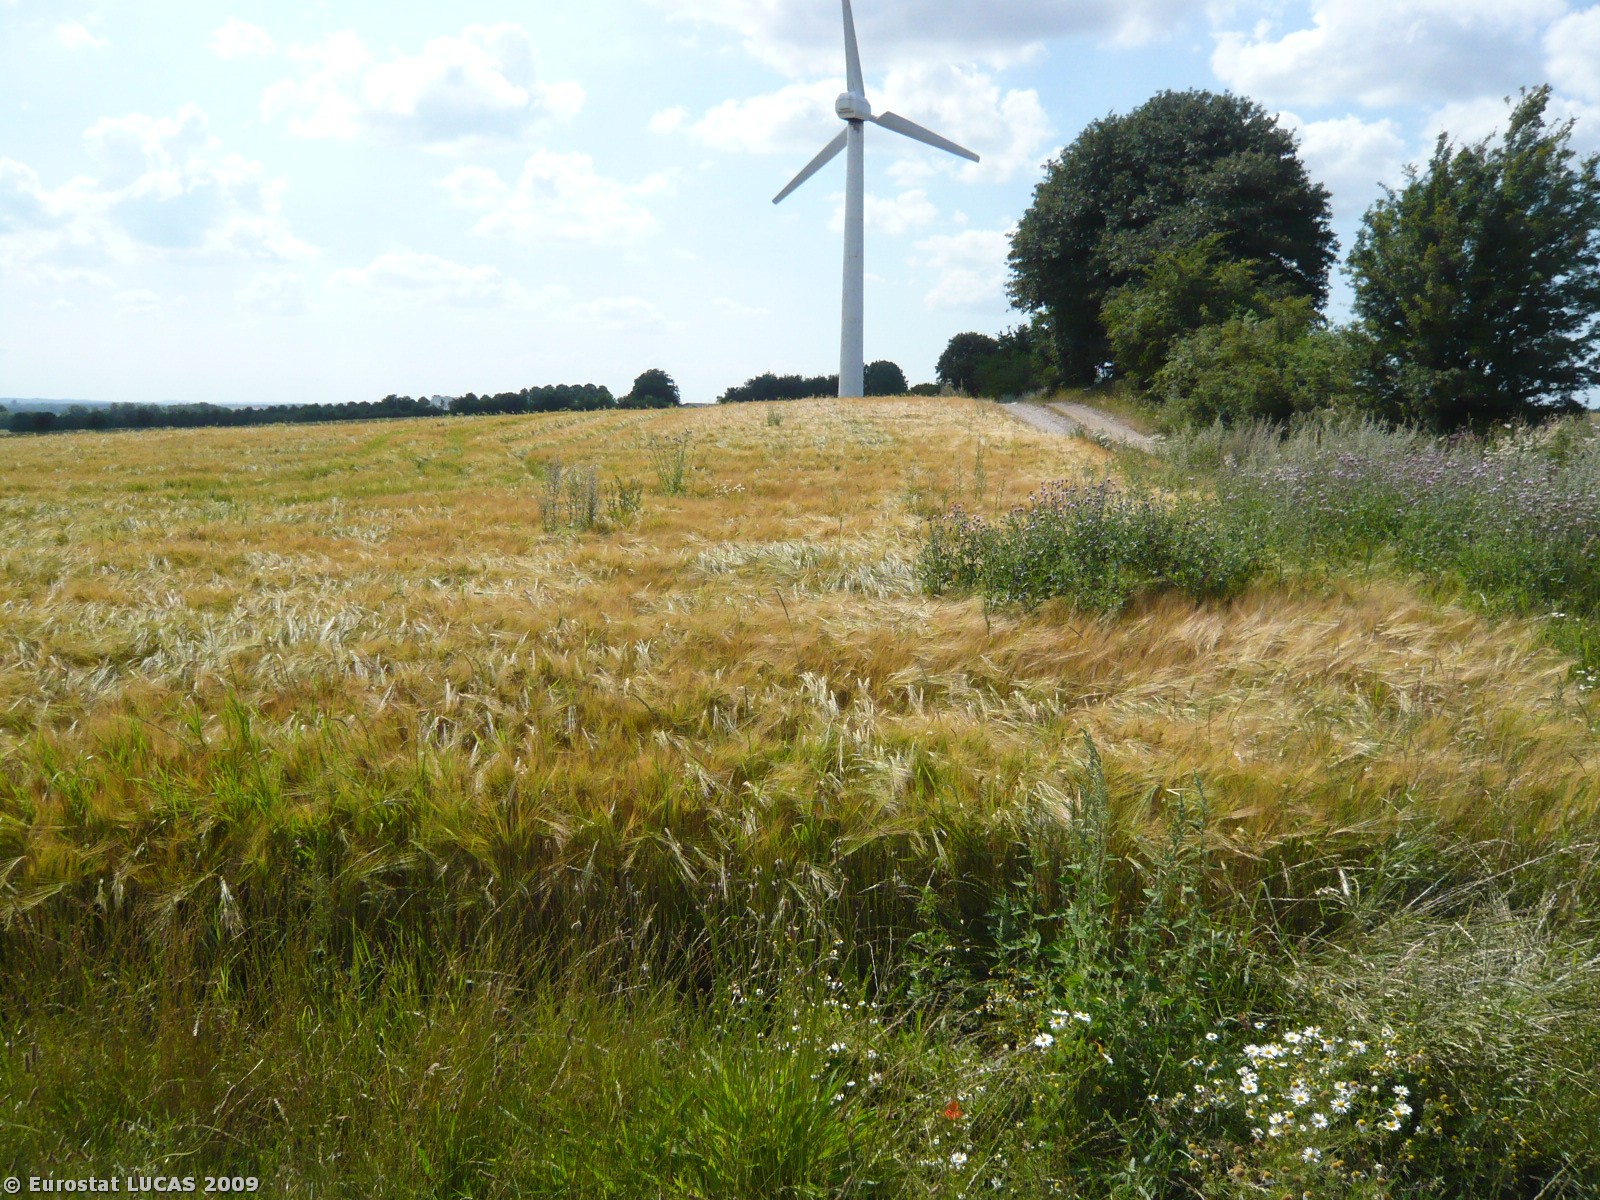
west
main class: Grassland
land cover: Grassland without tree/shrub cover
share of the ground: > 75 %
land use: Agriculture (excluding fallow land and kitchen gardens)
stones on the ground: < 10 %
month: July
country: DK
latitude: 55.7450
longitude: 11.7029
